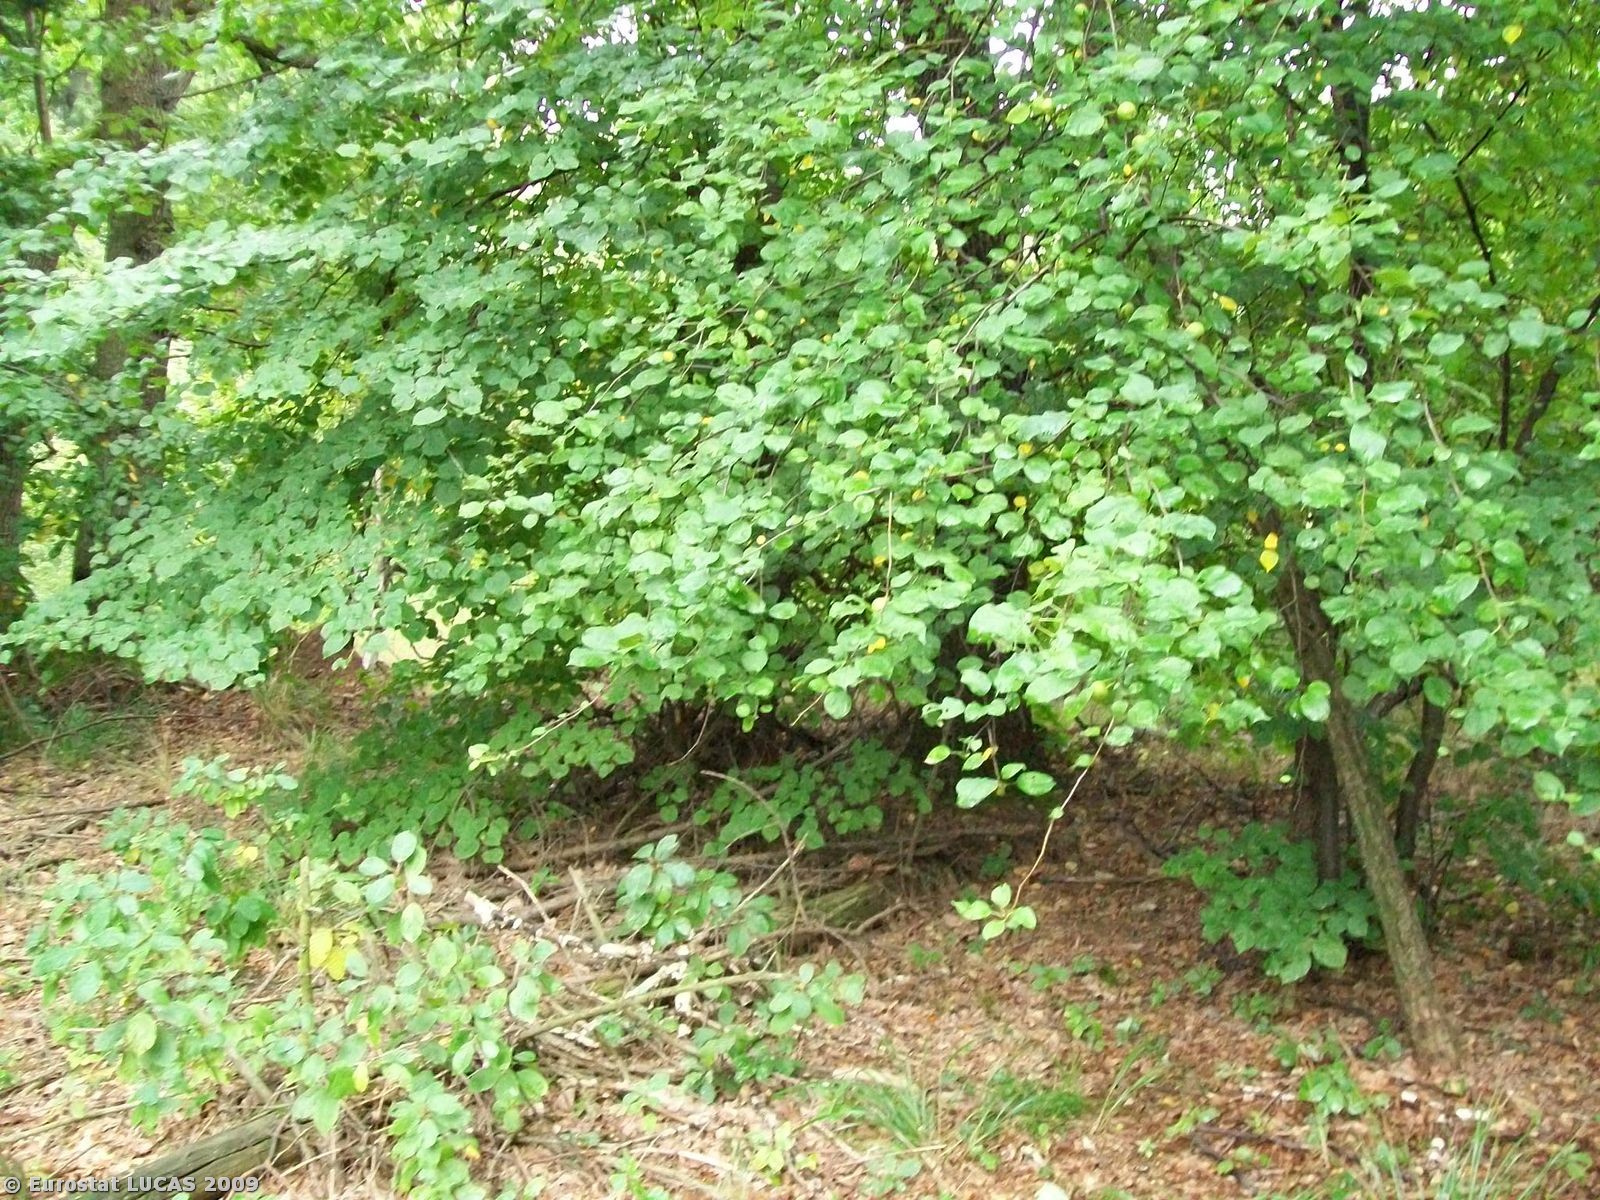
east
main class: Woodland
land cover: Mixed woodland
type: hemiboreal forest and nemoral coniferous forest and mixed broadleaved-coniferous forest
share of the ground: > 75 %
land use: Forestry
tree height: > 5 m
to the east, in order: Mixed woodland; Spontaneously vegetated surfaces; Grassland without tree/shrub cover; Broadleaved woodland
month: September
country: PL
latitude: 50.7409
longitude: 16.7684
